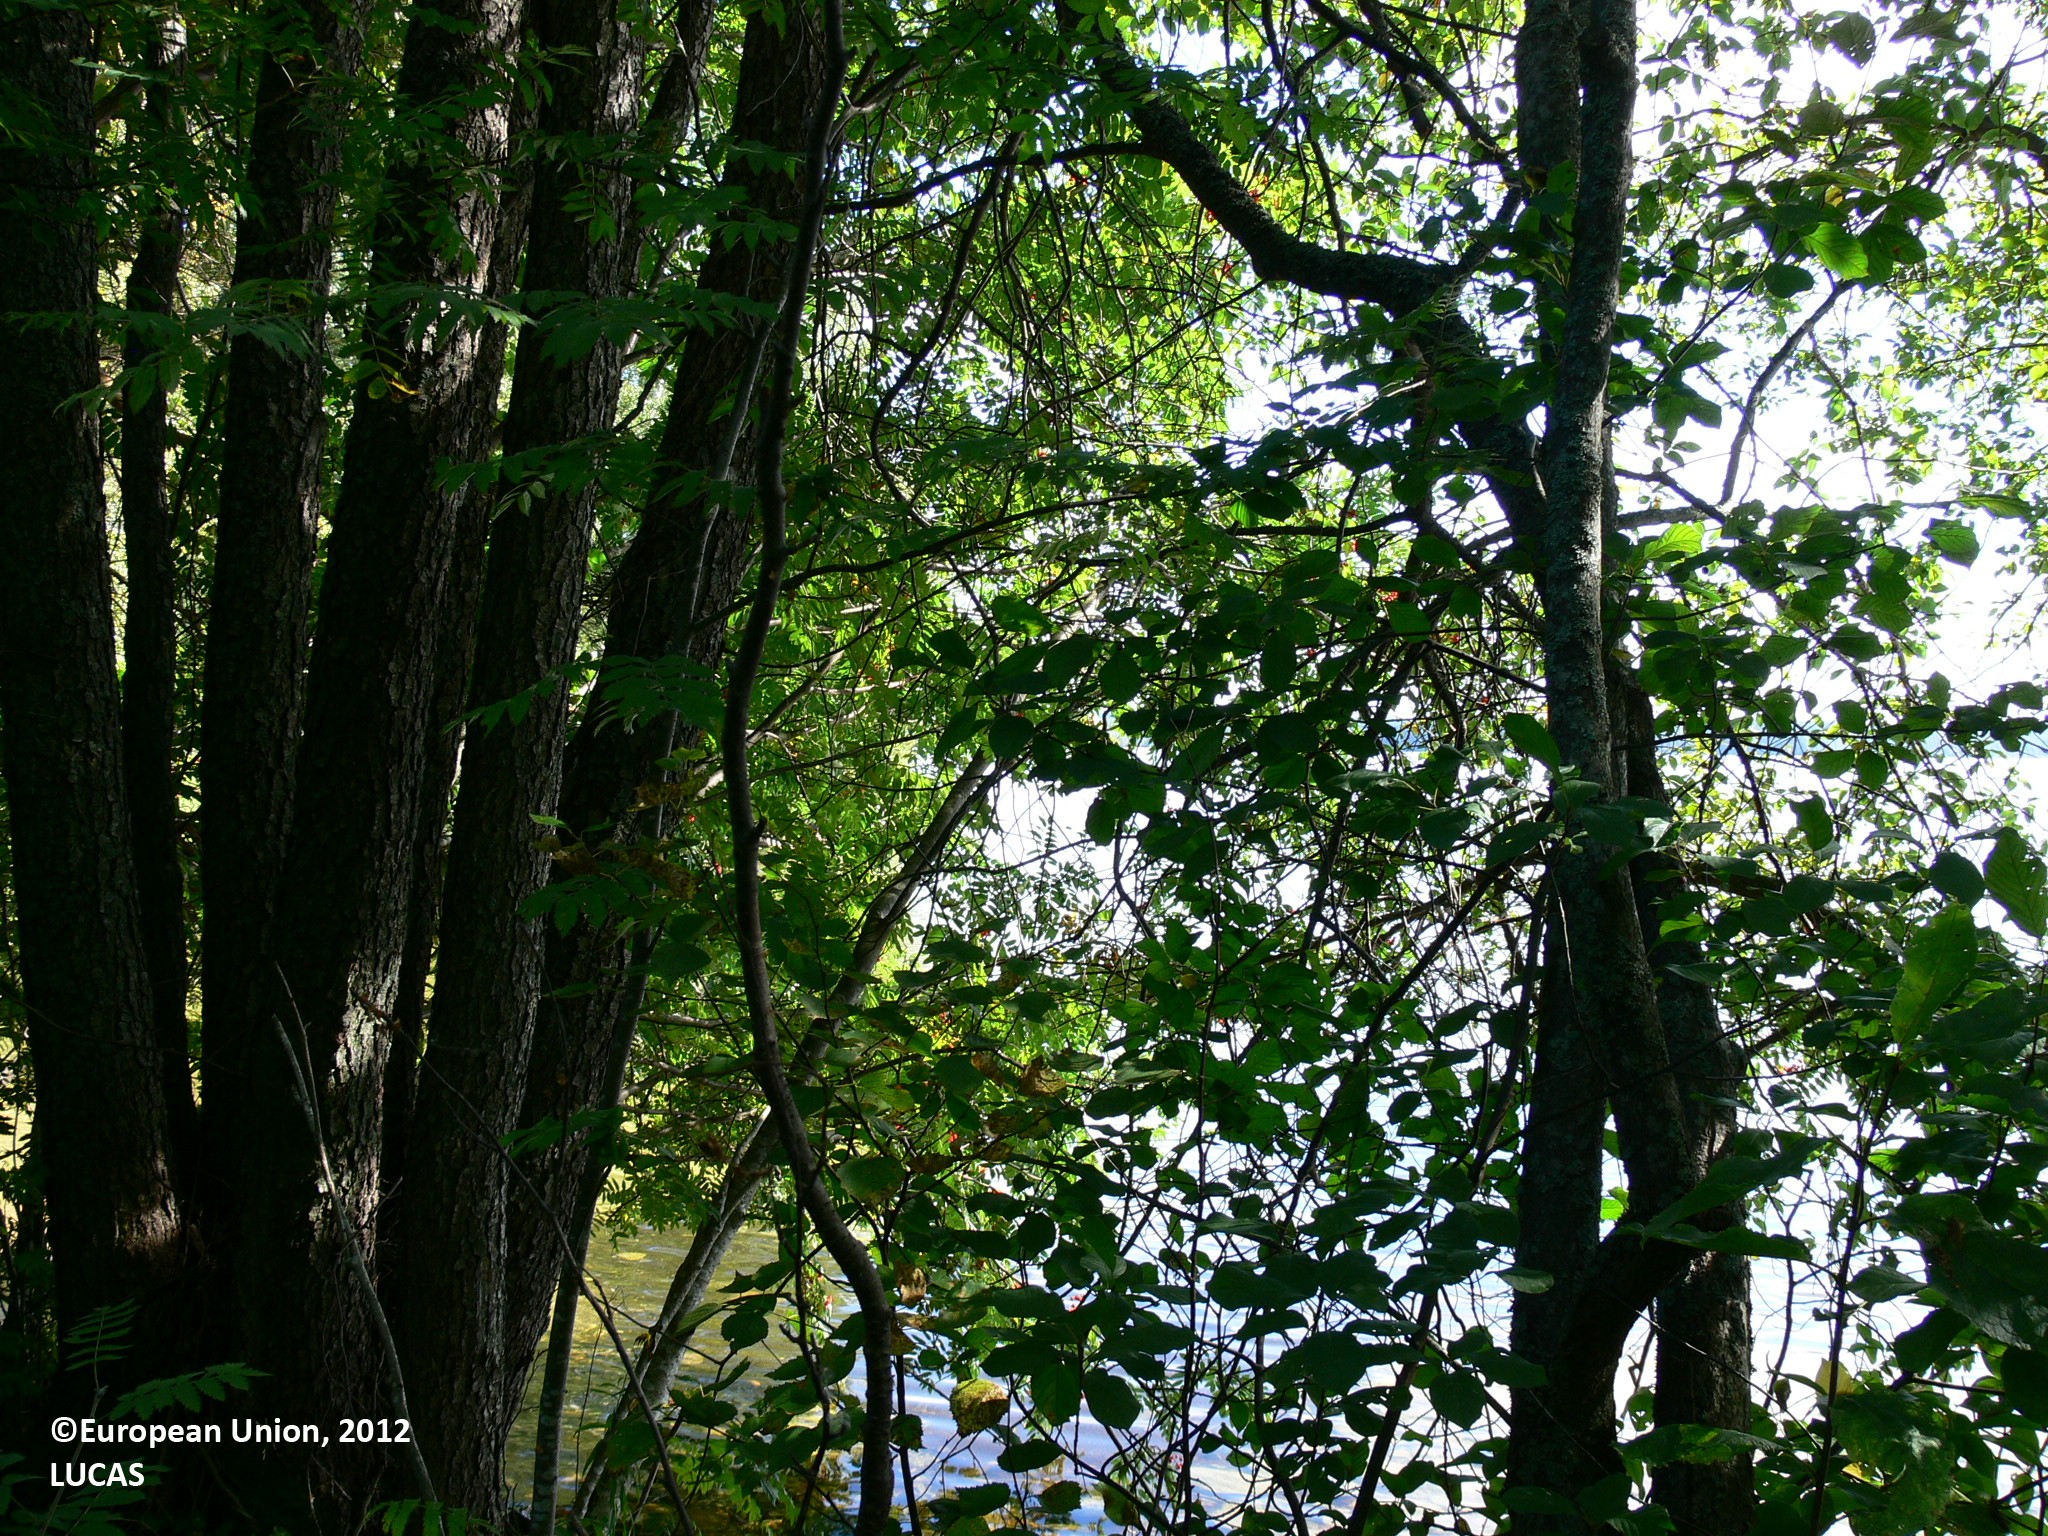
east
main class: Woodland
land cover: Broadleaved woodland
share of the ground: 50 - 75 %
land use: Forestry
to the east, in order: Broadleaved woodland; Inland water bodies; Broadleaved woodland; Inland water bodies
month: August
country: FI
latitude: 61.9180
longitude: 30.0150
